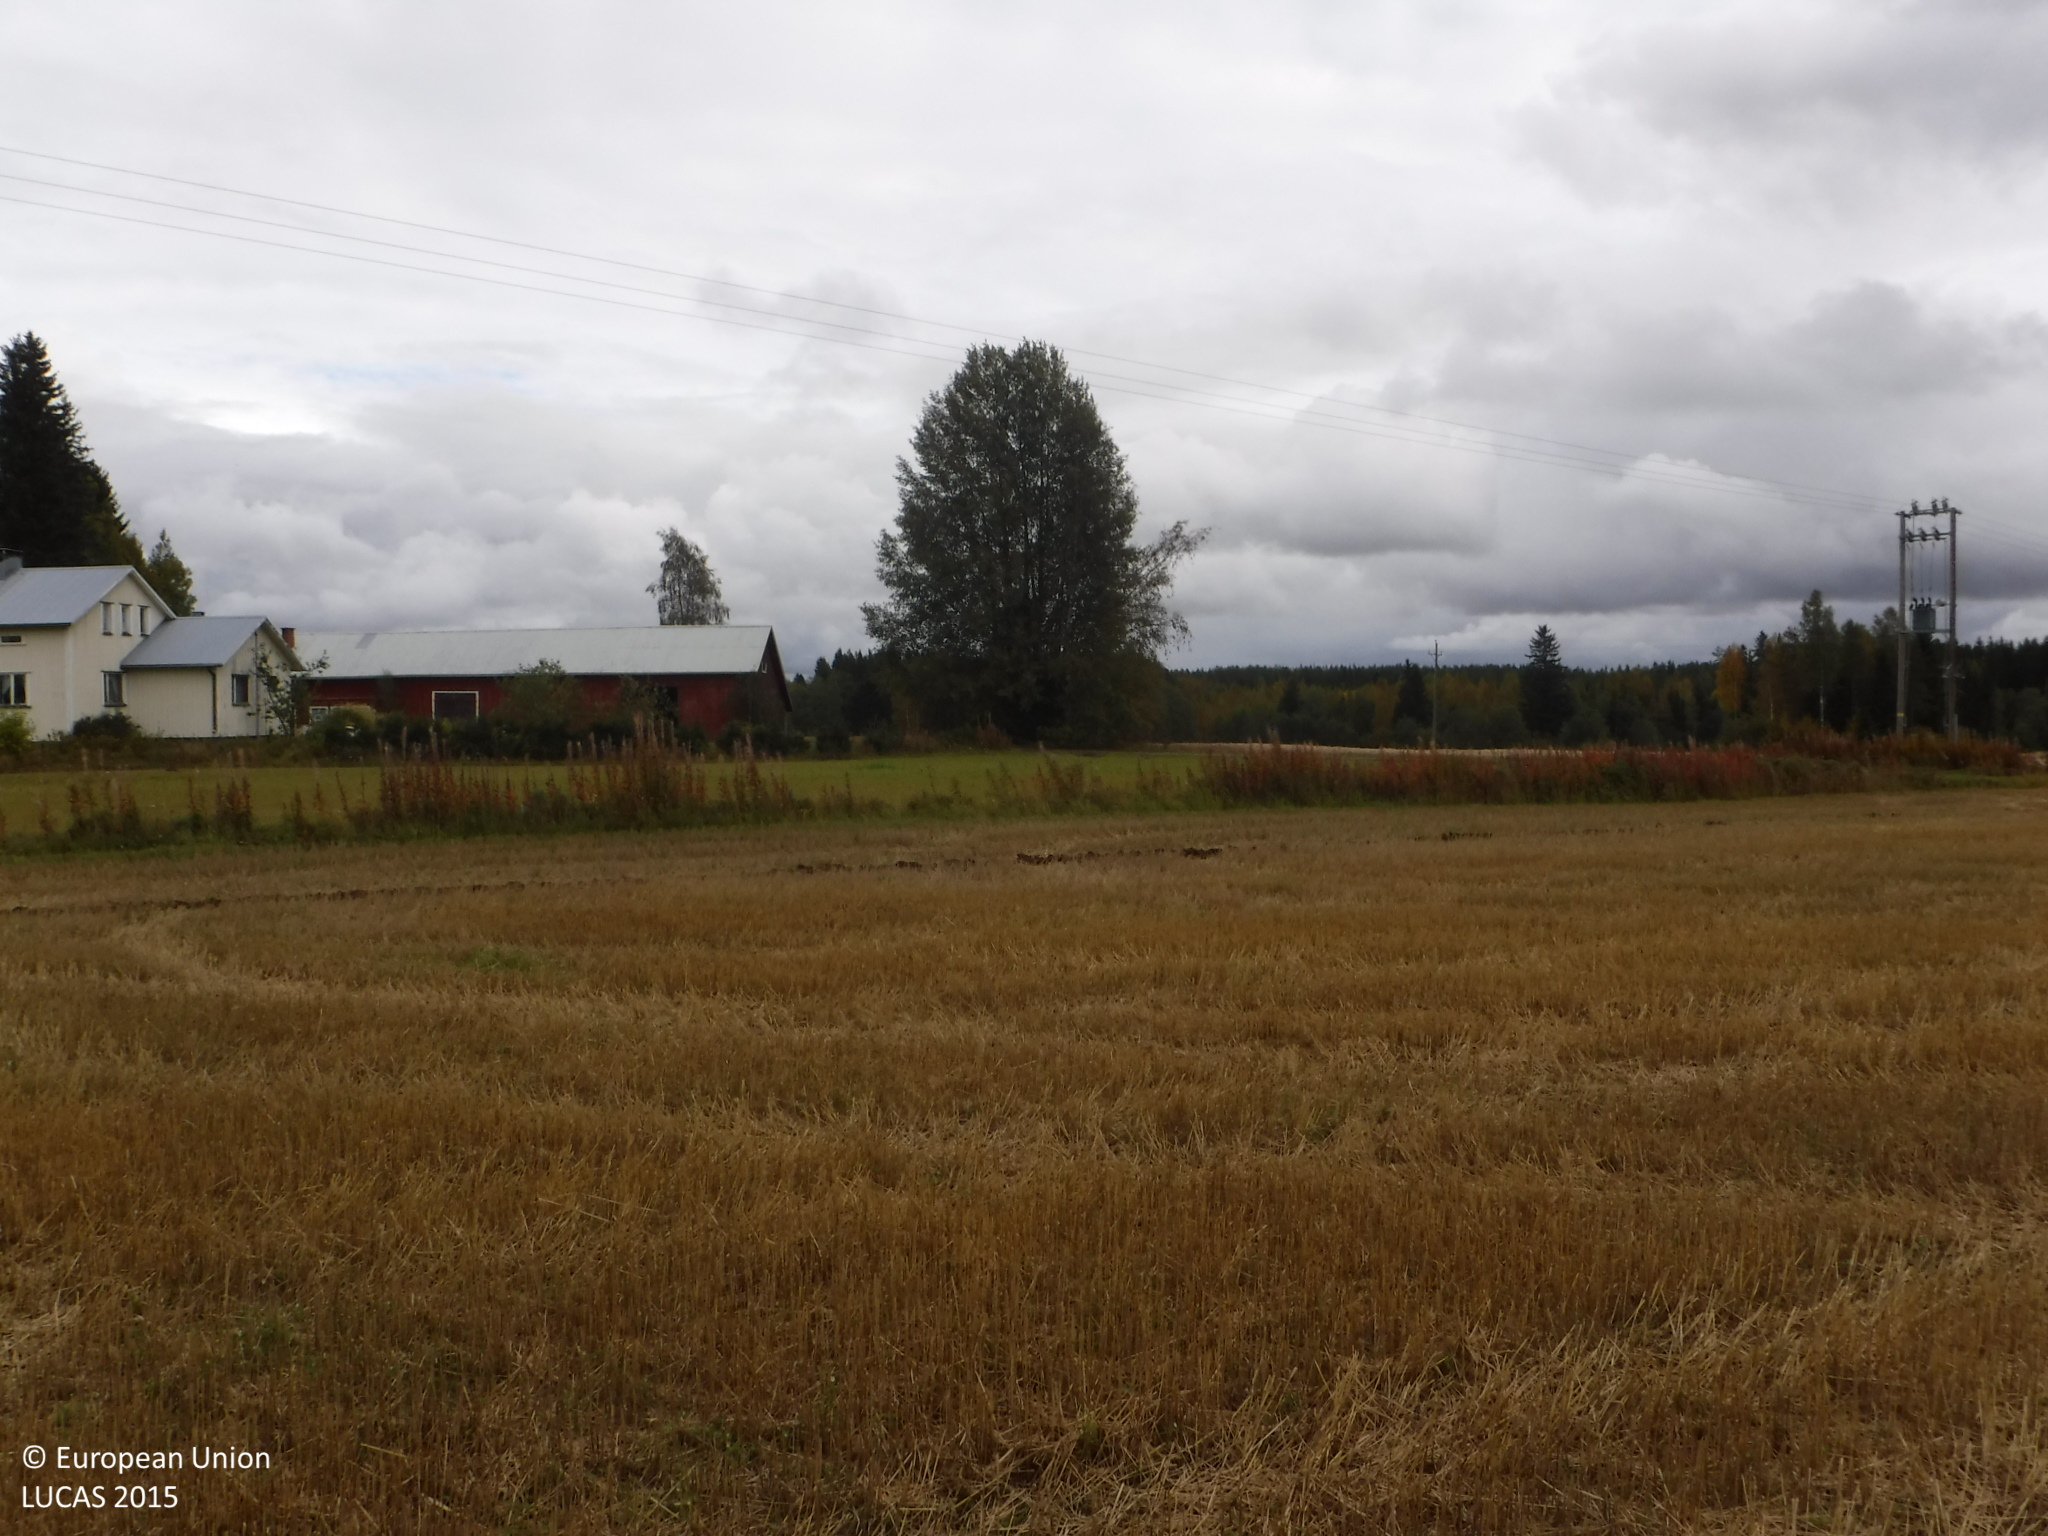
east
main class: Cropland
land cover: Barley
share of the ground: > 75 %
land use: Agriculture (excluding fallow land and kitchen gardens)
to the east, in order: Barley; Grass margins; Ditches and canals; Grass margins; Electric lines; Temporary grasslands; Grass margins; Artificial constructions in urban areas; Single bushes/trees; Grass margins; Barley; Electric lines; Barley
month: September
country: FI
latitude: 62.0914
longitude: 22.2549
